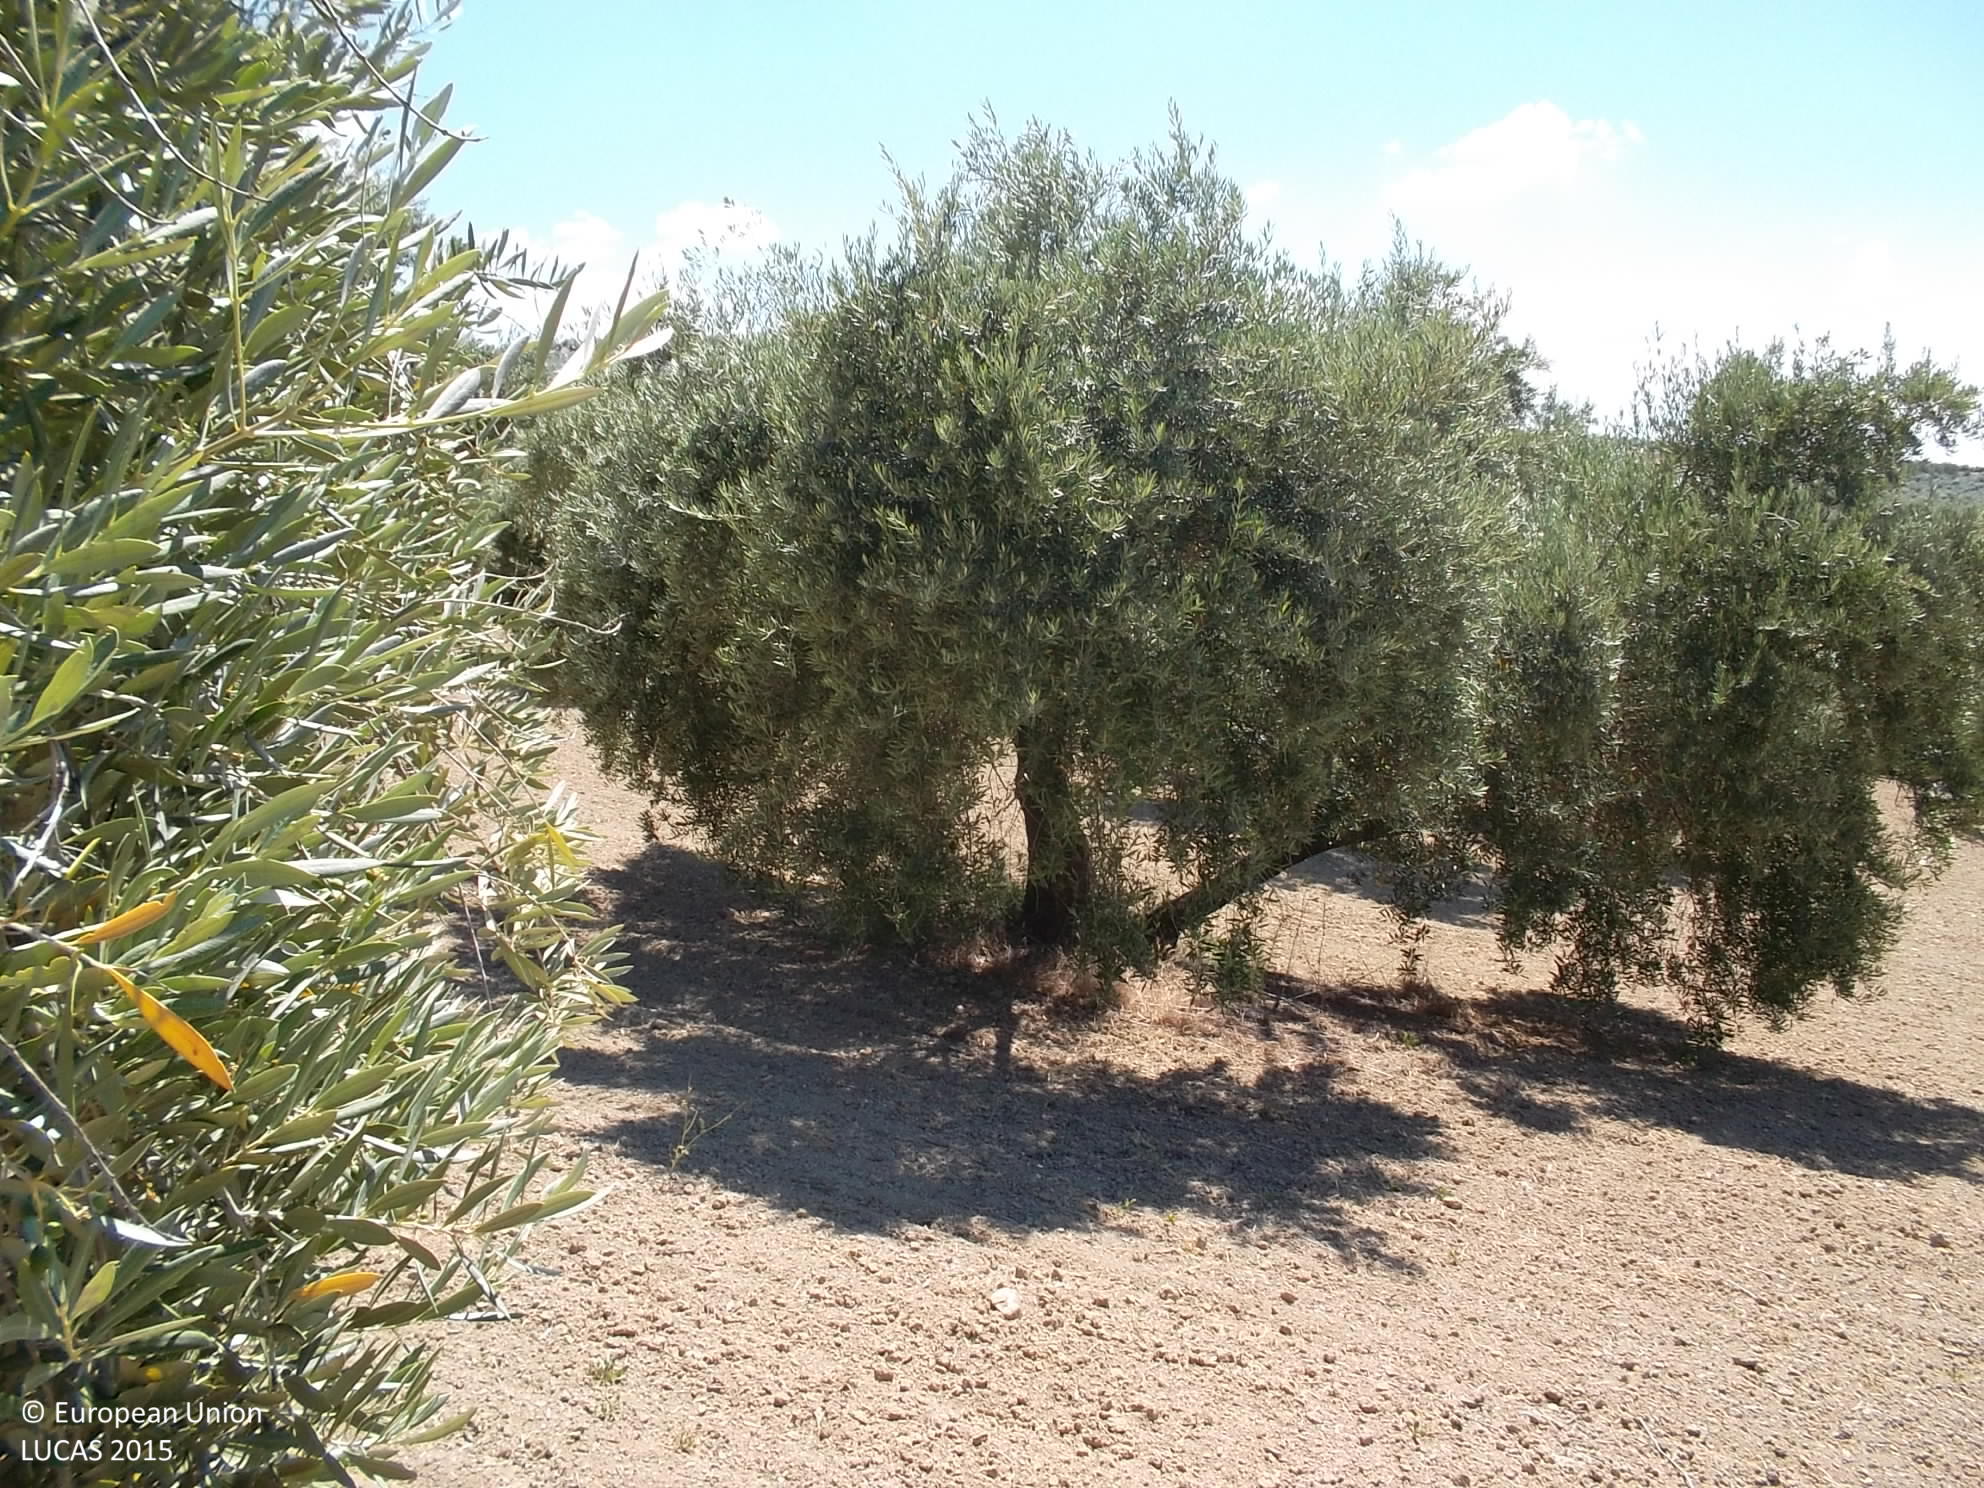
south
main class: Cropland
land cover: Olive groves
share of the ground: 25 - 50 %
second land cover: Other bare soil
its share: > 75 %
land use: Agriculture (excluding fallow land and kitchen gardens)
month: June
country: ES
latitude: 38.0340
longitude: -3.0655
